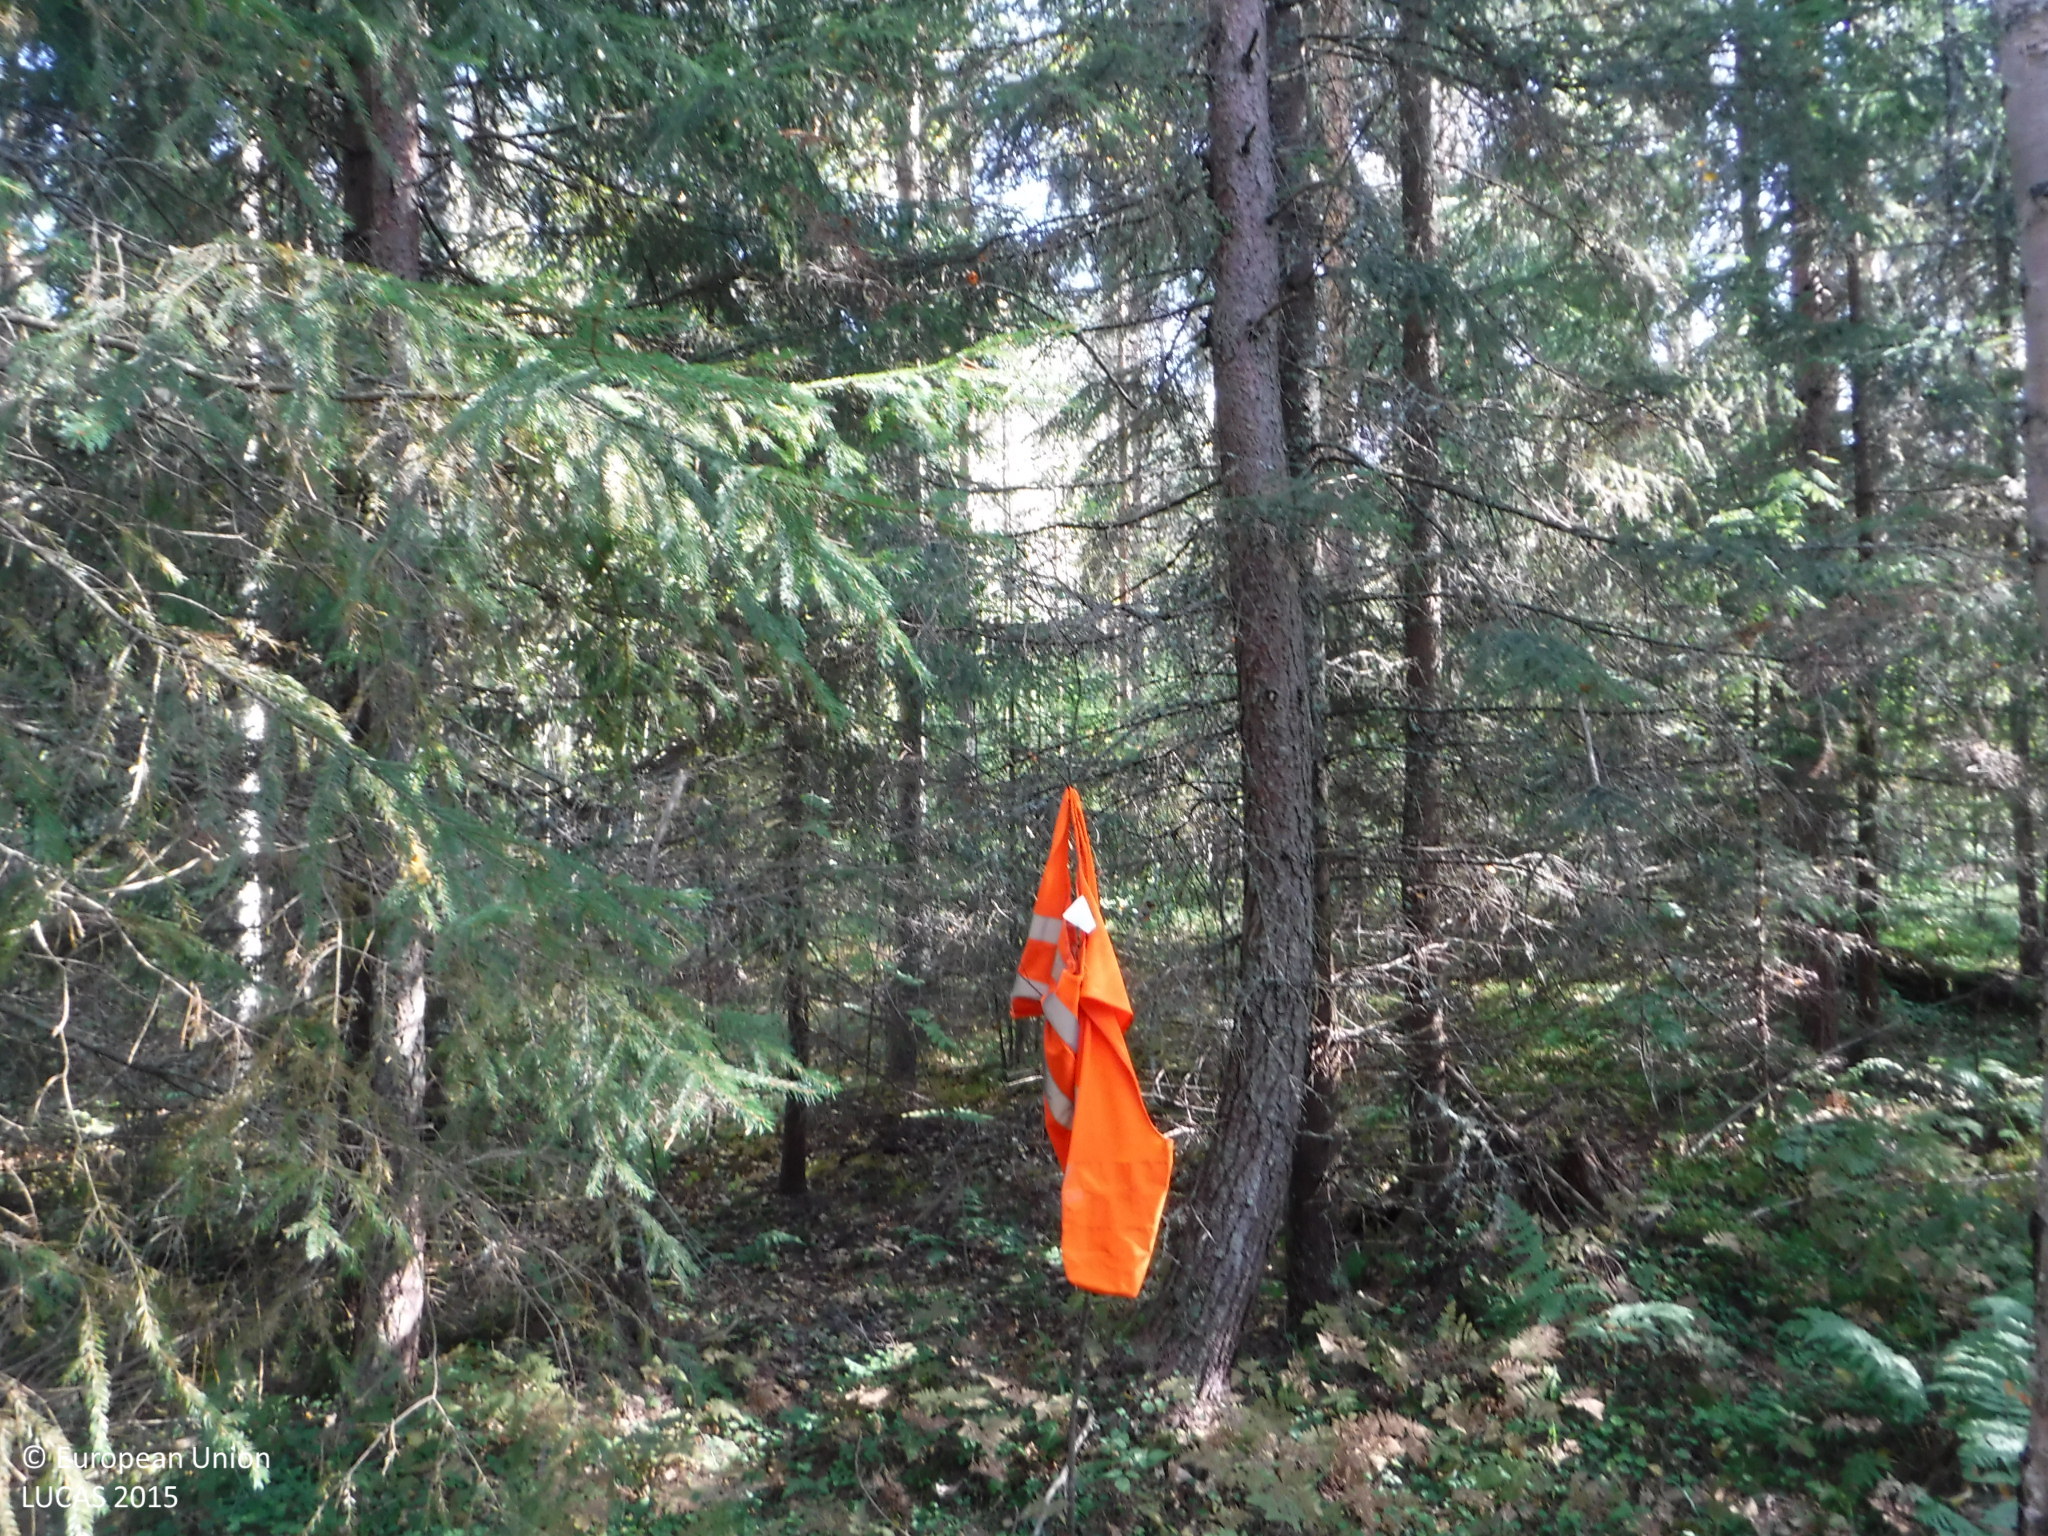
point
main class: Woodland
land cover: Other mixed woodland
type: boreal forest
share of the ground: 50 - 75 %
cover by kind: coniferous forest trees 40 %, broadleaved forest trees 30 %, lichens and mosses 25 %, herbaceous plants 5 %
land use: Forestry
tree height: > 5 m
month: September
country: FI
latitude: 61.7961
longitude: 22.7155
